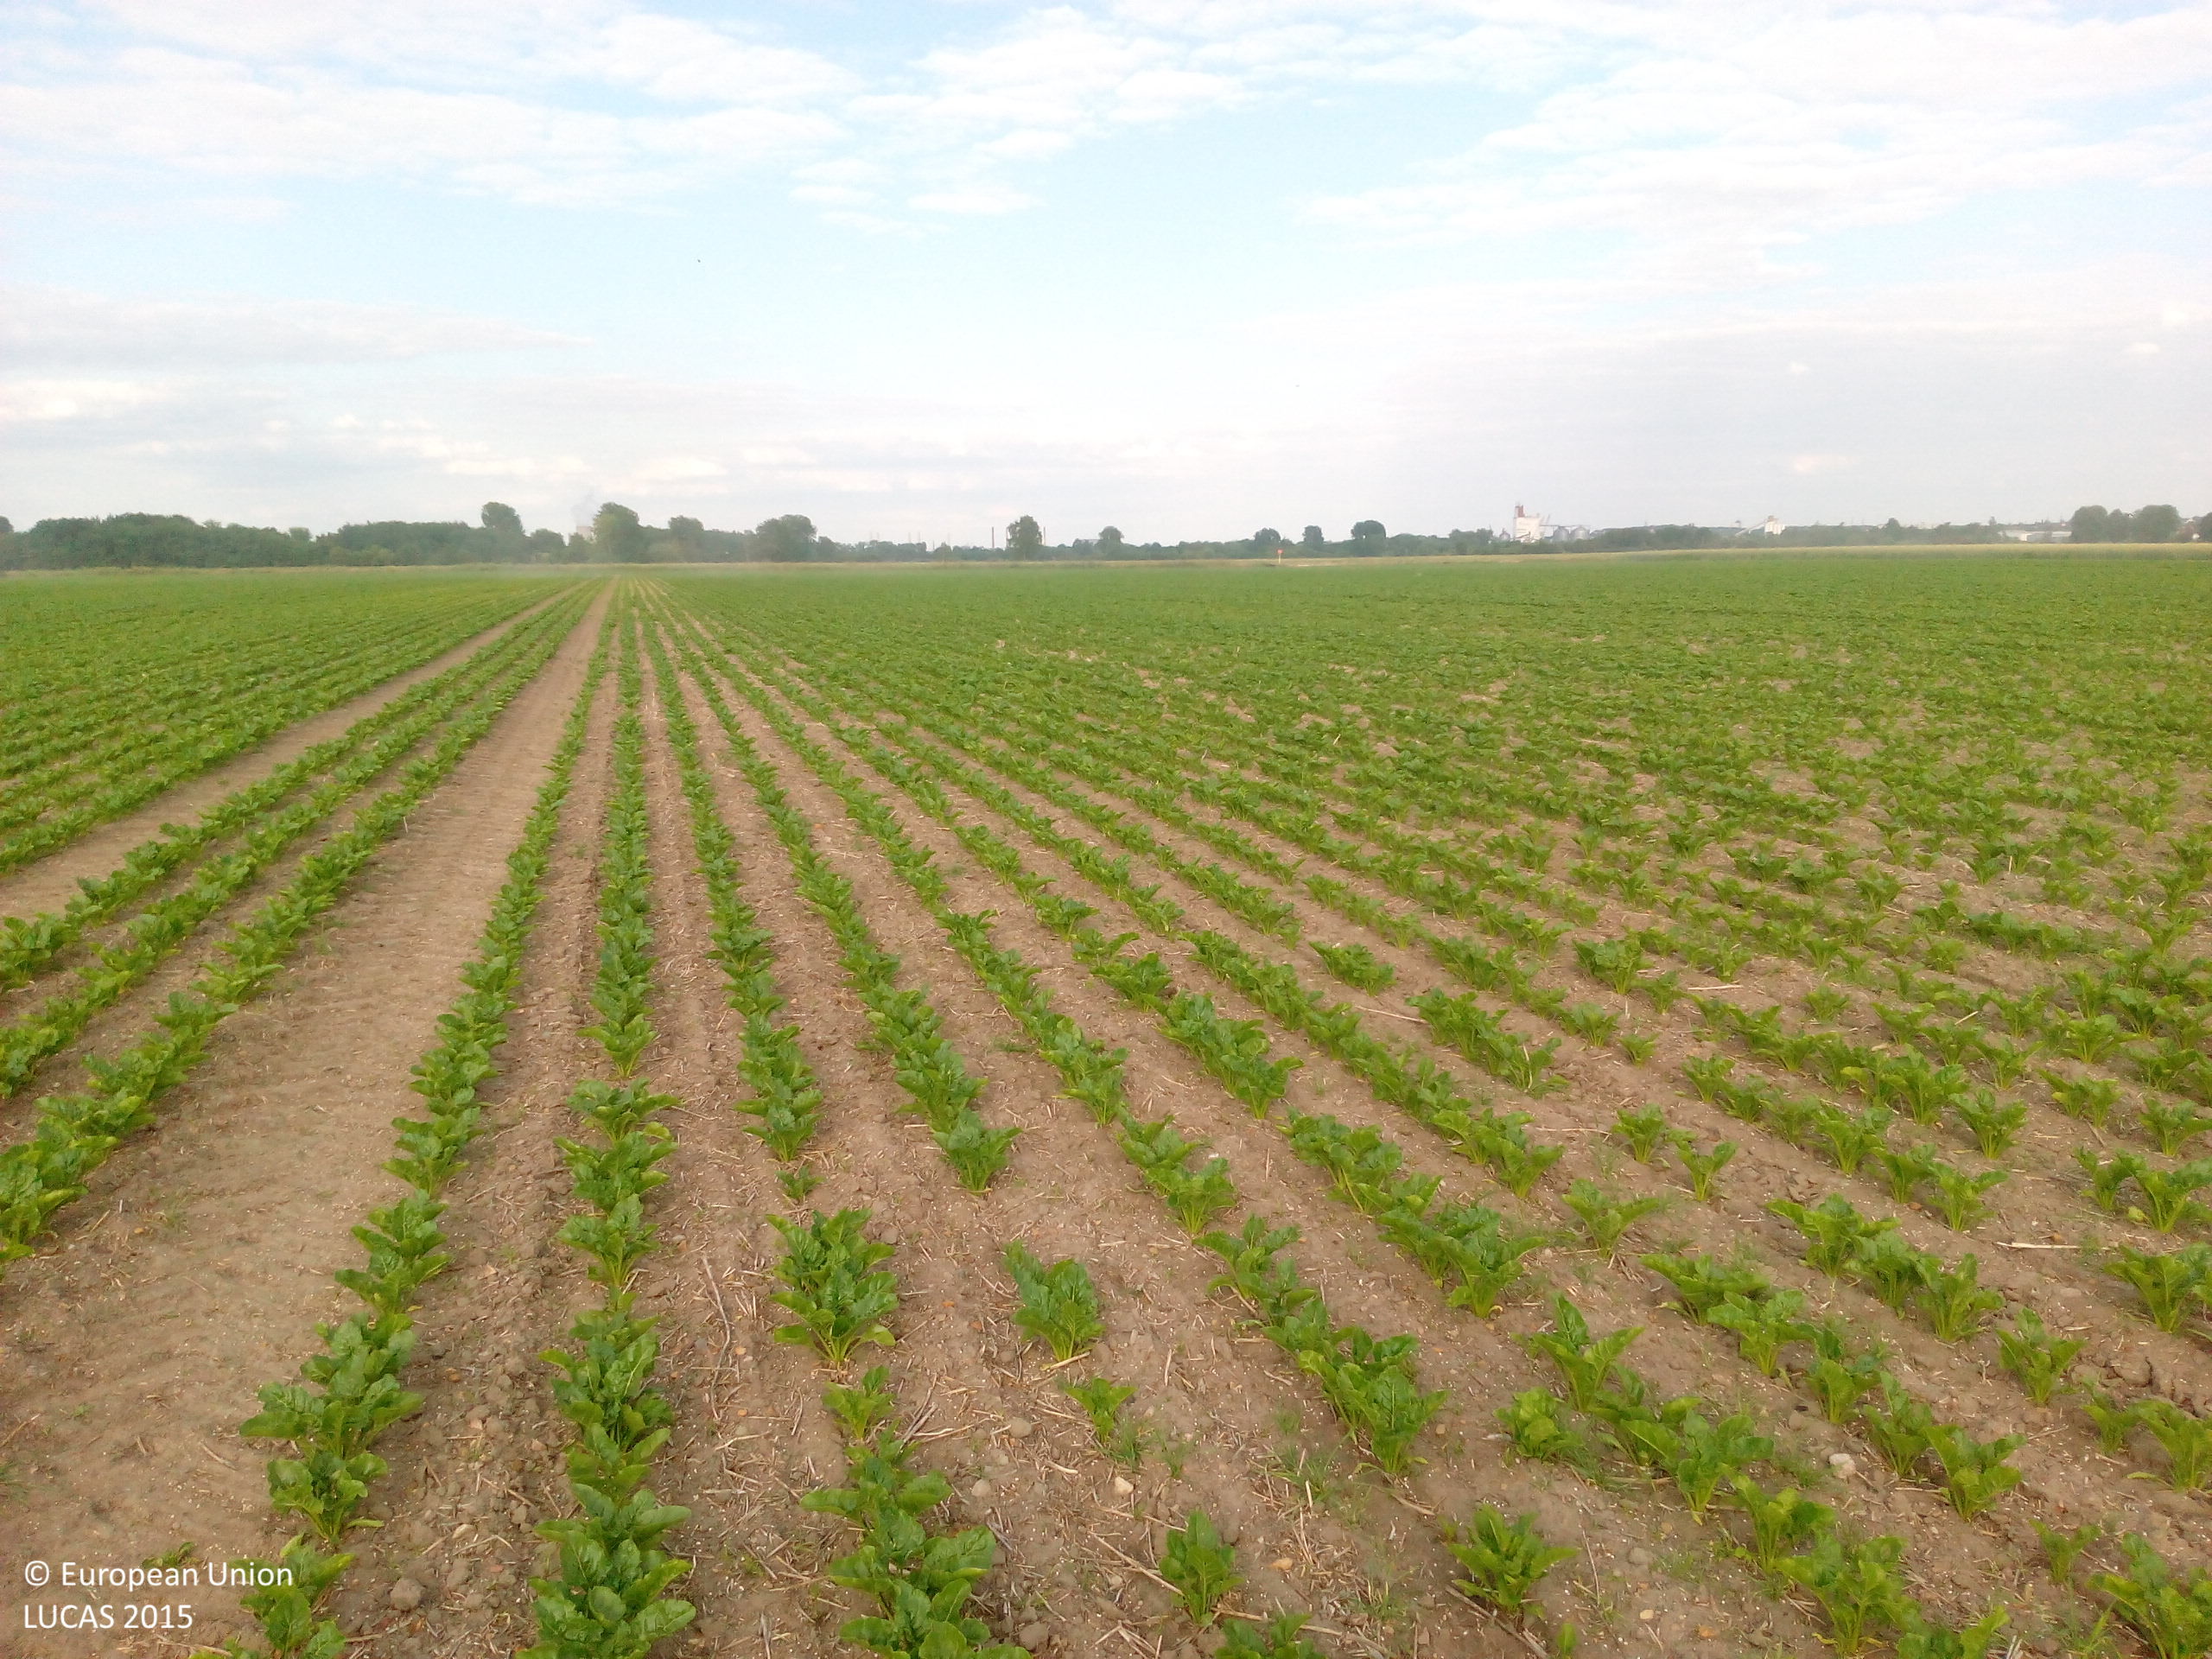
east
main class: Cropland
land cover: Sugar beet
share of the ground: < 10 %
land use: Agriculture (excluding fallow land and kitchen gardens)
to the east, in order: Sugar beet; Grass margins; Tracks
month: June
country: DE
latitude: 52.4294
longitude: 10.6910
